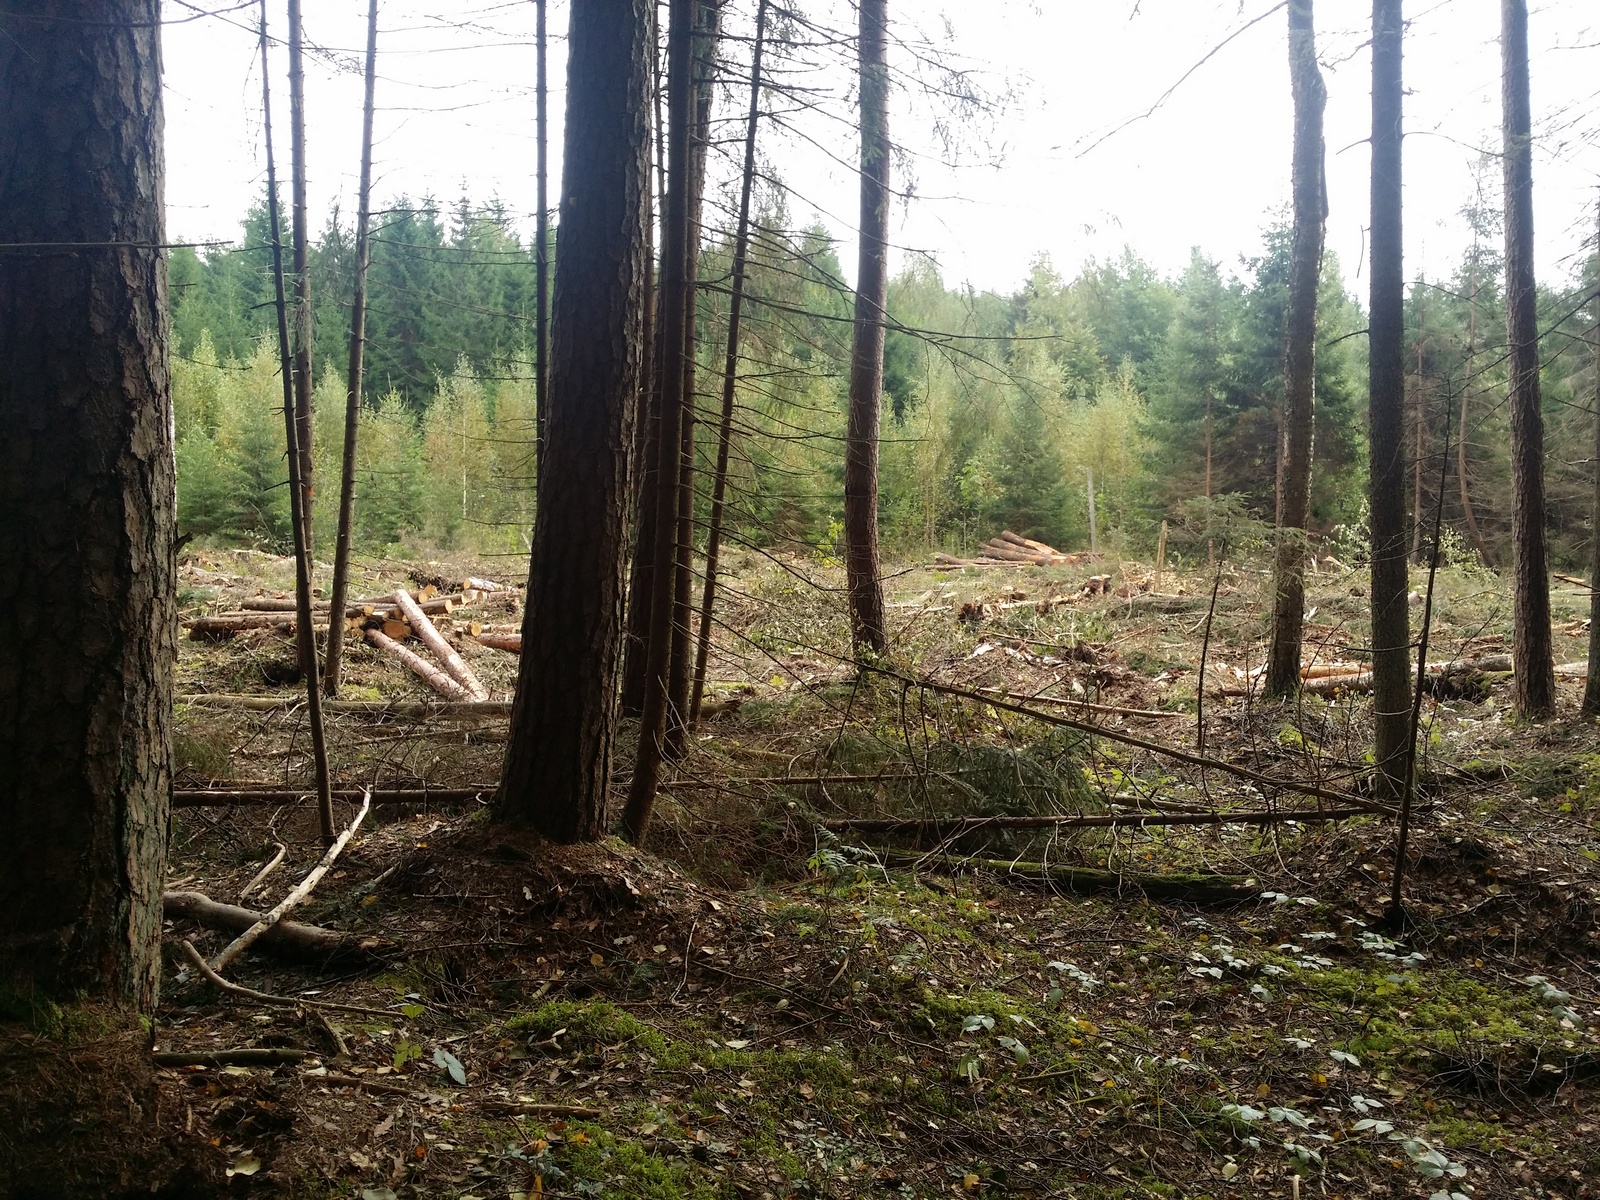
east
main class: Woodland
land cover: Spruce dominated coniferous woodland
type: hemiboreal forest and nemoral coniferous forest and mixed broadleaved-coniferous forest
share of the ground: > 75 %
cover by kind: coniferous forest trees 85 %, lichens and mosses 15 %
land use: Forestry
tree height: > 5 m
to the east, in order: Spruce dominated coniferous woodland; Spruce dominated mixed woodland; Spruce dominated coniferous woodland; Tracks; Spruce dominated coniferous woodland
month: September
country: LV
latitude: 57.3034
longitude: 27.3148
